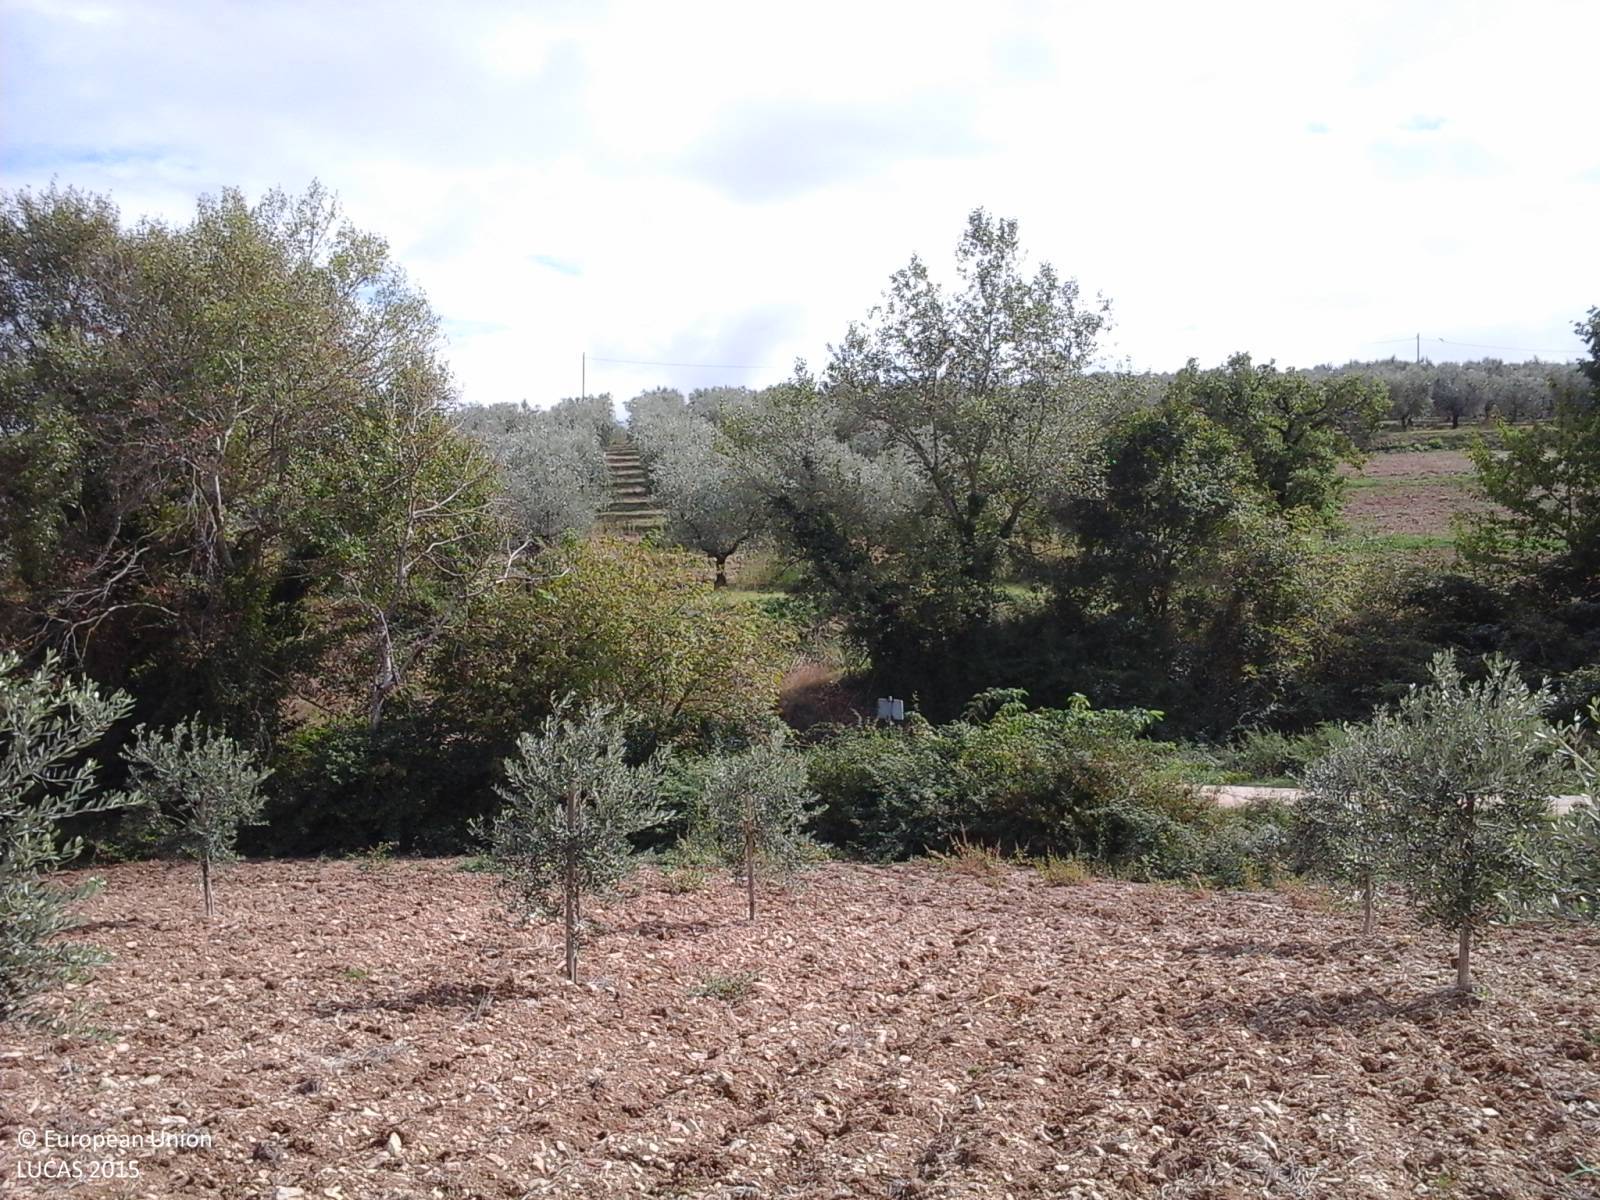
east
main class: Cropland
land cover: Olive groves
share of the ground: 10 - 25 %
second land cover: Other bare soil
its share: > 75 %
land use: Agriculture (excluding fallow land and kitchen gardens)
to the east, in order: Olive groves; Other bare soil; Abandoned hedges; Rivers and streams; Abandoned hedges; Tracks; Grass margins; Olive groves; Grass margins; Tracks; Grass margins; Olive groves; Tracks; Olive groves
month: September
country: IT
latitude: 42.8375
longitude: 12.5981
